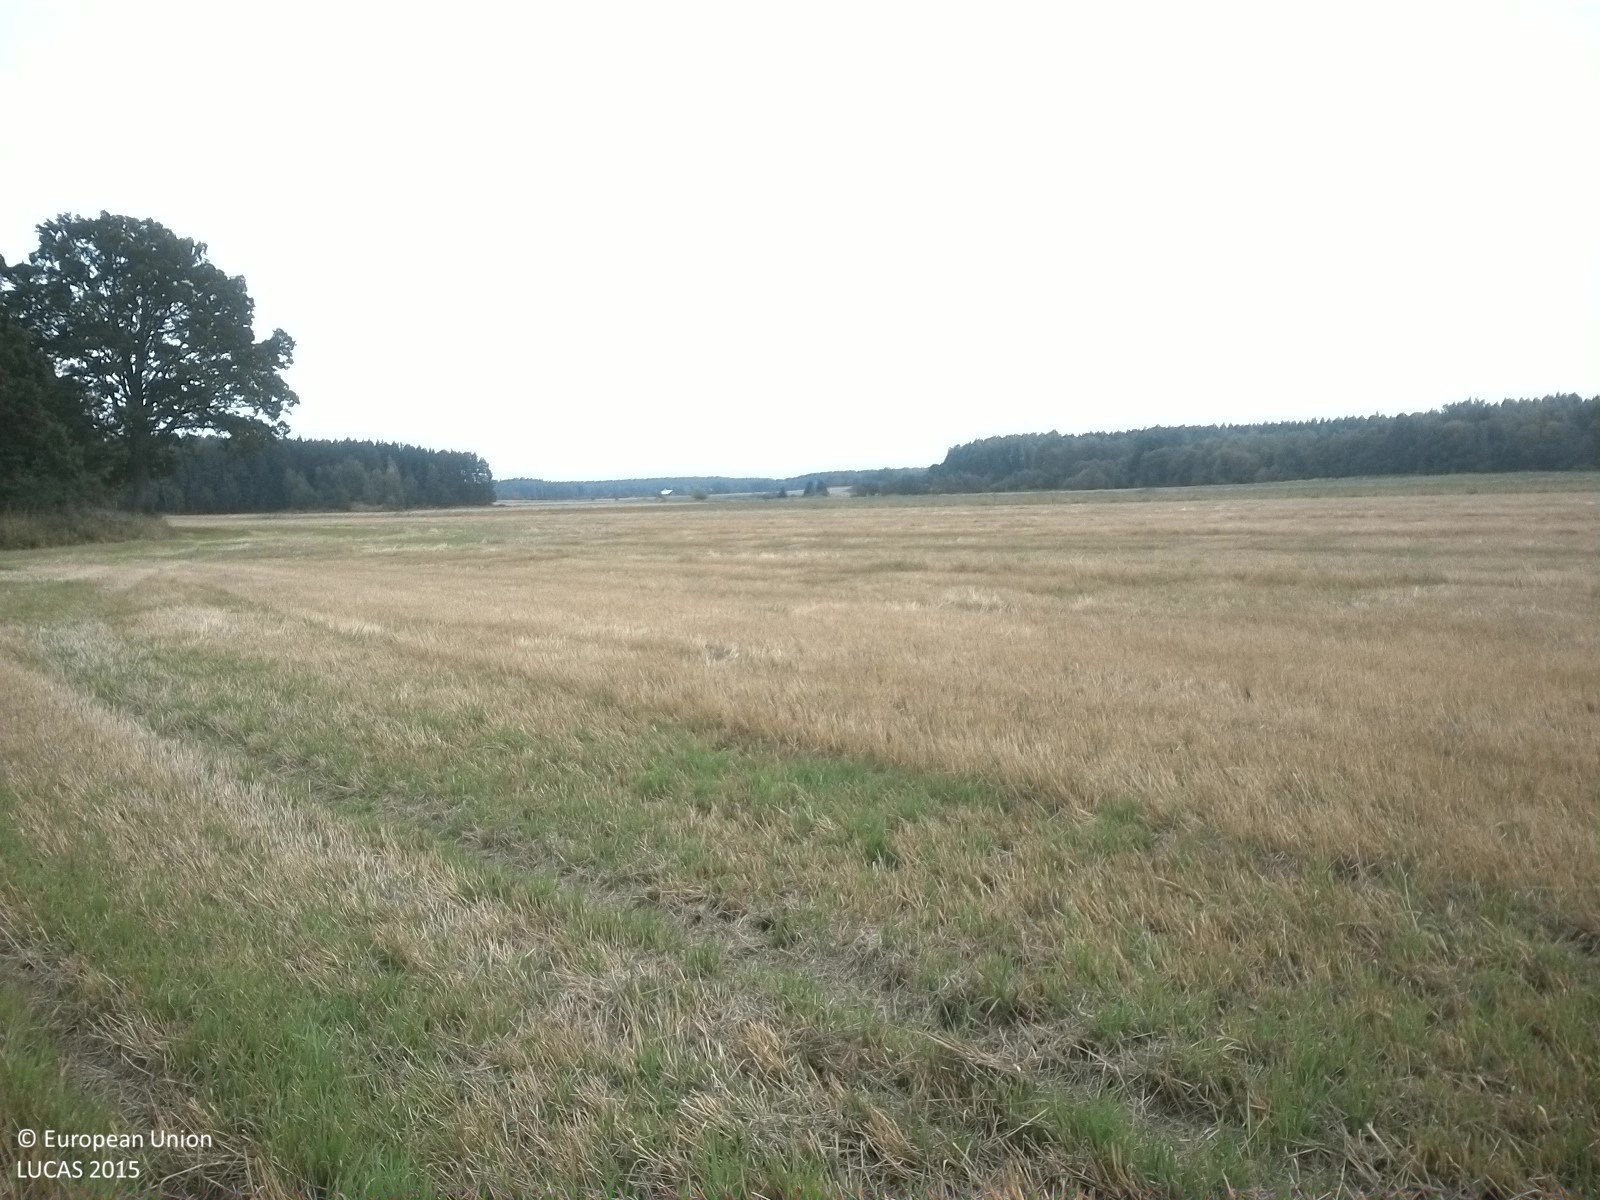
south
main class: Cropland
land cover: Temporary grasslands
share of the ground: > 75 %
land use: Agriculture (excluding fallow land and kitchen gardens)
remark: Harvested field
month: September
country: SE
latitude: 58.5884
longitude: 16.4466
